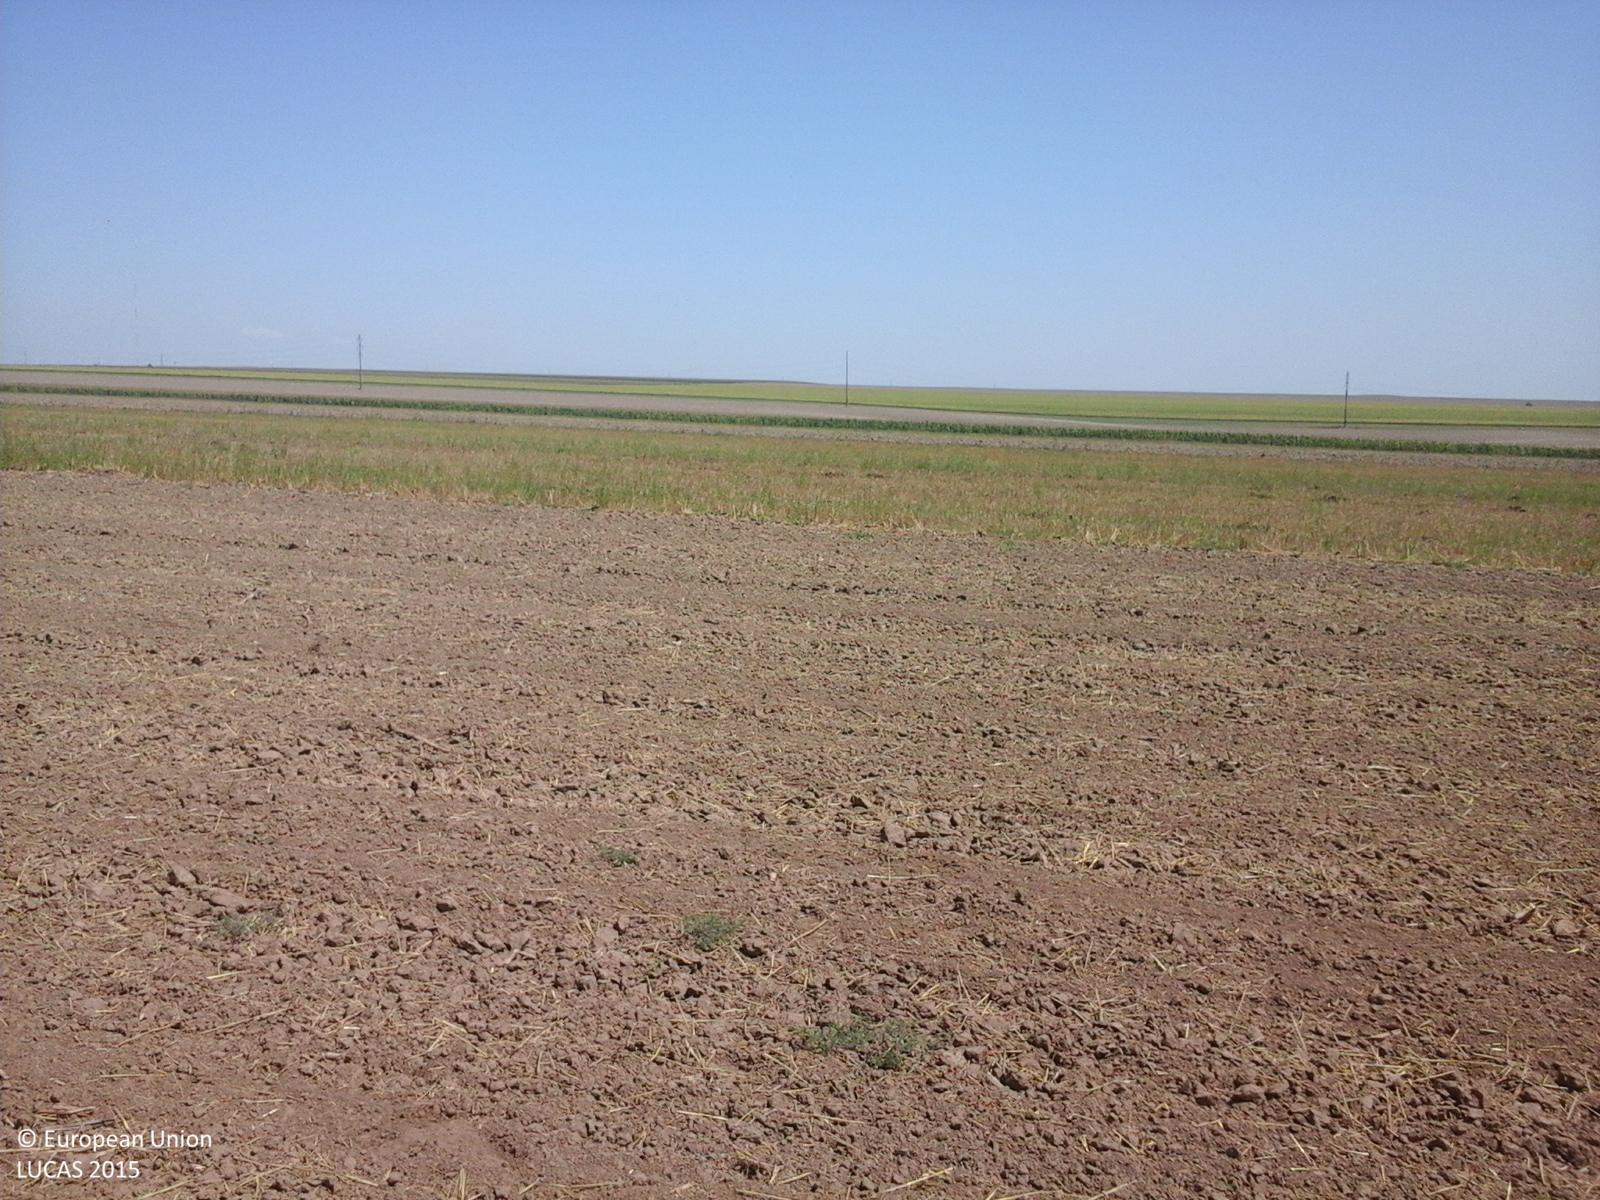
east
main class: Cropland
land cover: Common wheat
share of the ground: < 10 %
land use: Agriculture (excluding fallow land and kitchen gardens)
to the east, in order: Common wheat; Other bare soil; Common wheat; Maize
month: August
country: RO
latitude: 44.6333
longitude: 28.0484
